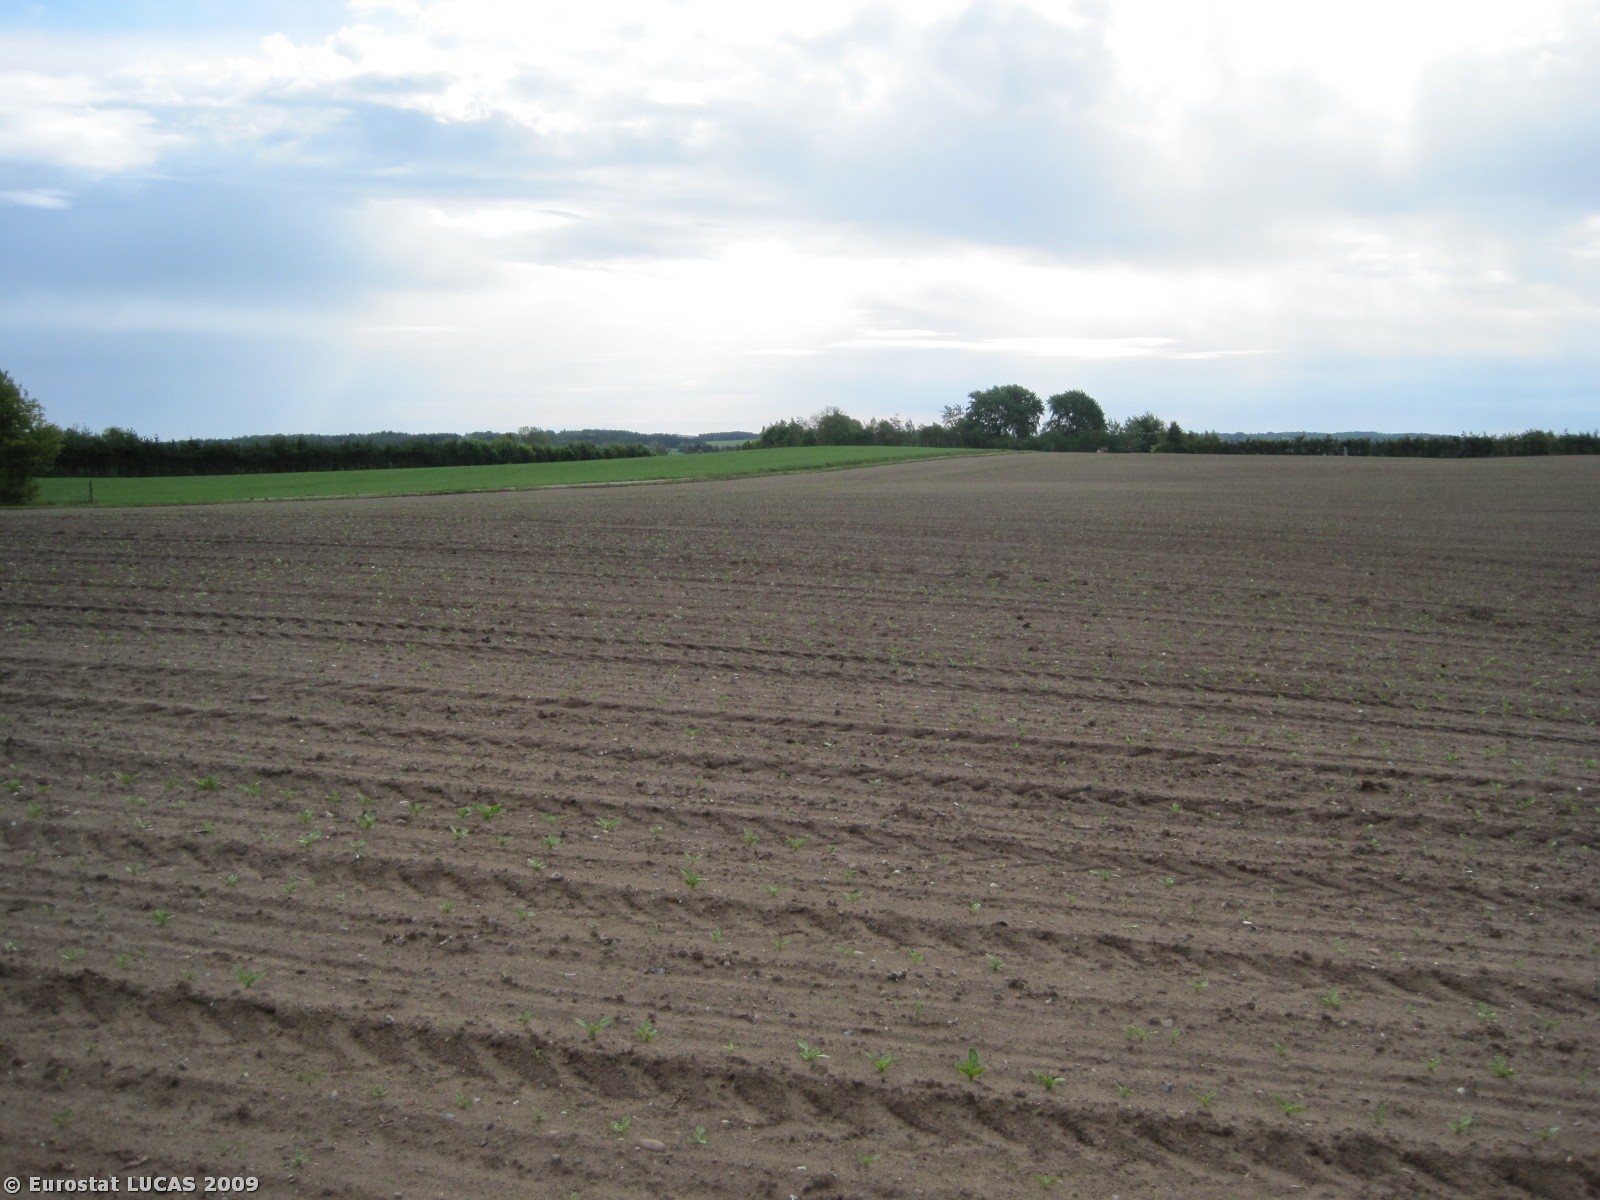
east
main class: Cropland
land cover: Sugar beet
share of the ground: < 10 %
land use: Agriculture (excluding fallow land and kitchen gardens)
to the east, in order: Sugar beet; Grass margins; Tracks; Grass margins; Barley
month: May
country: DK
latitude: 56.7090
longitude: 10.0163
